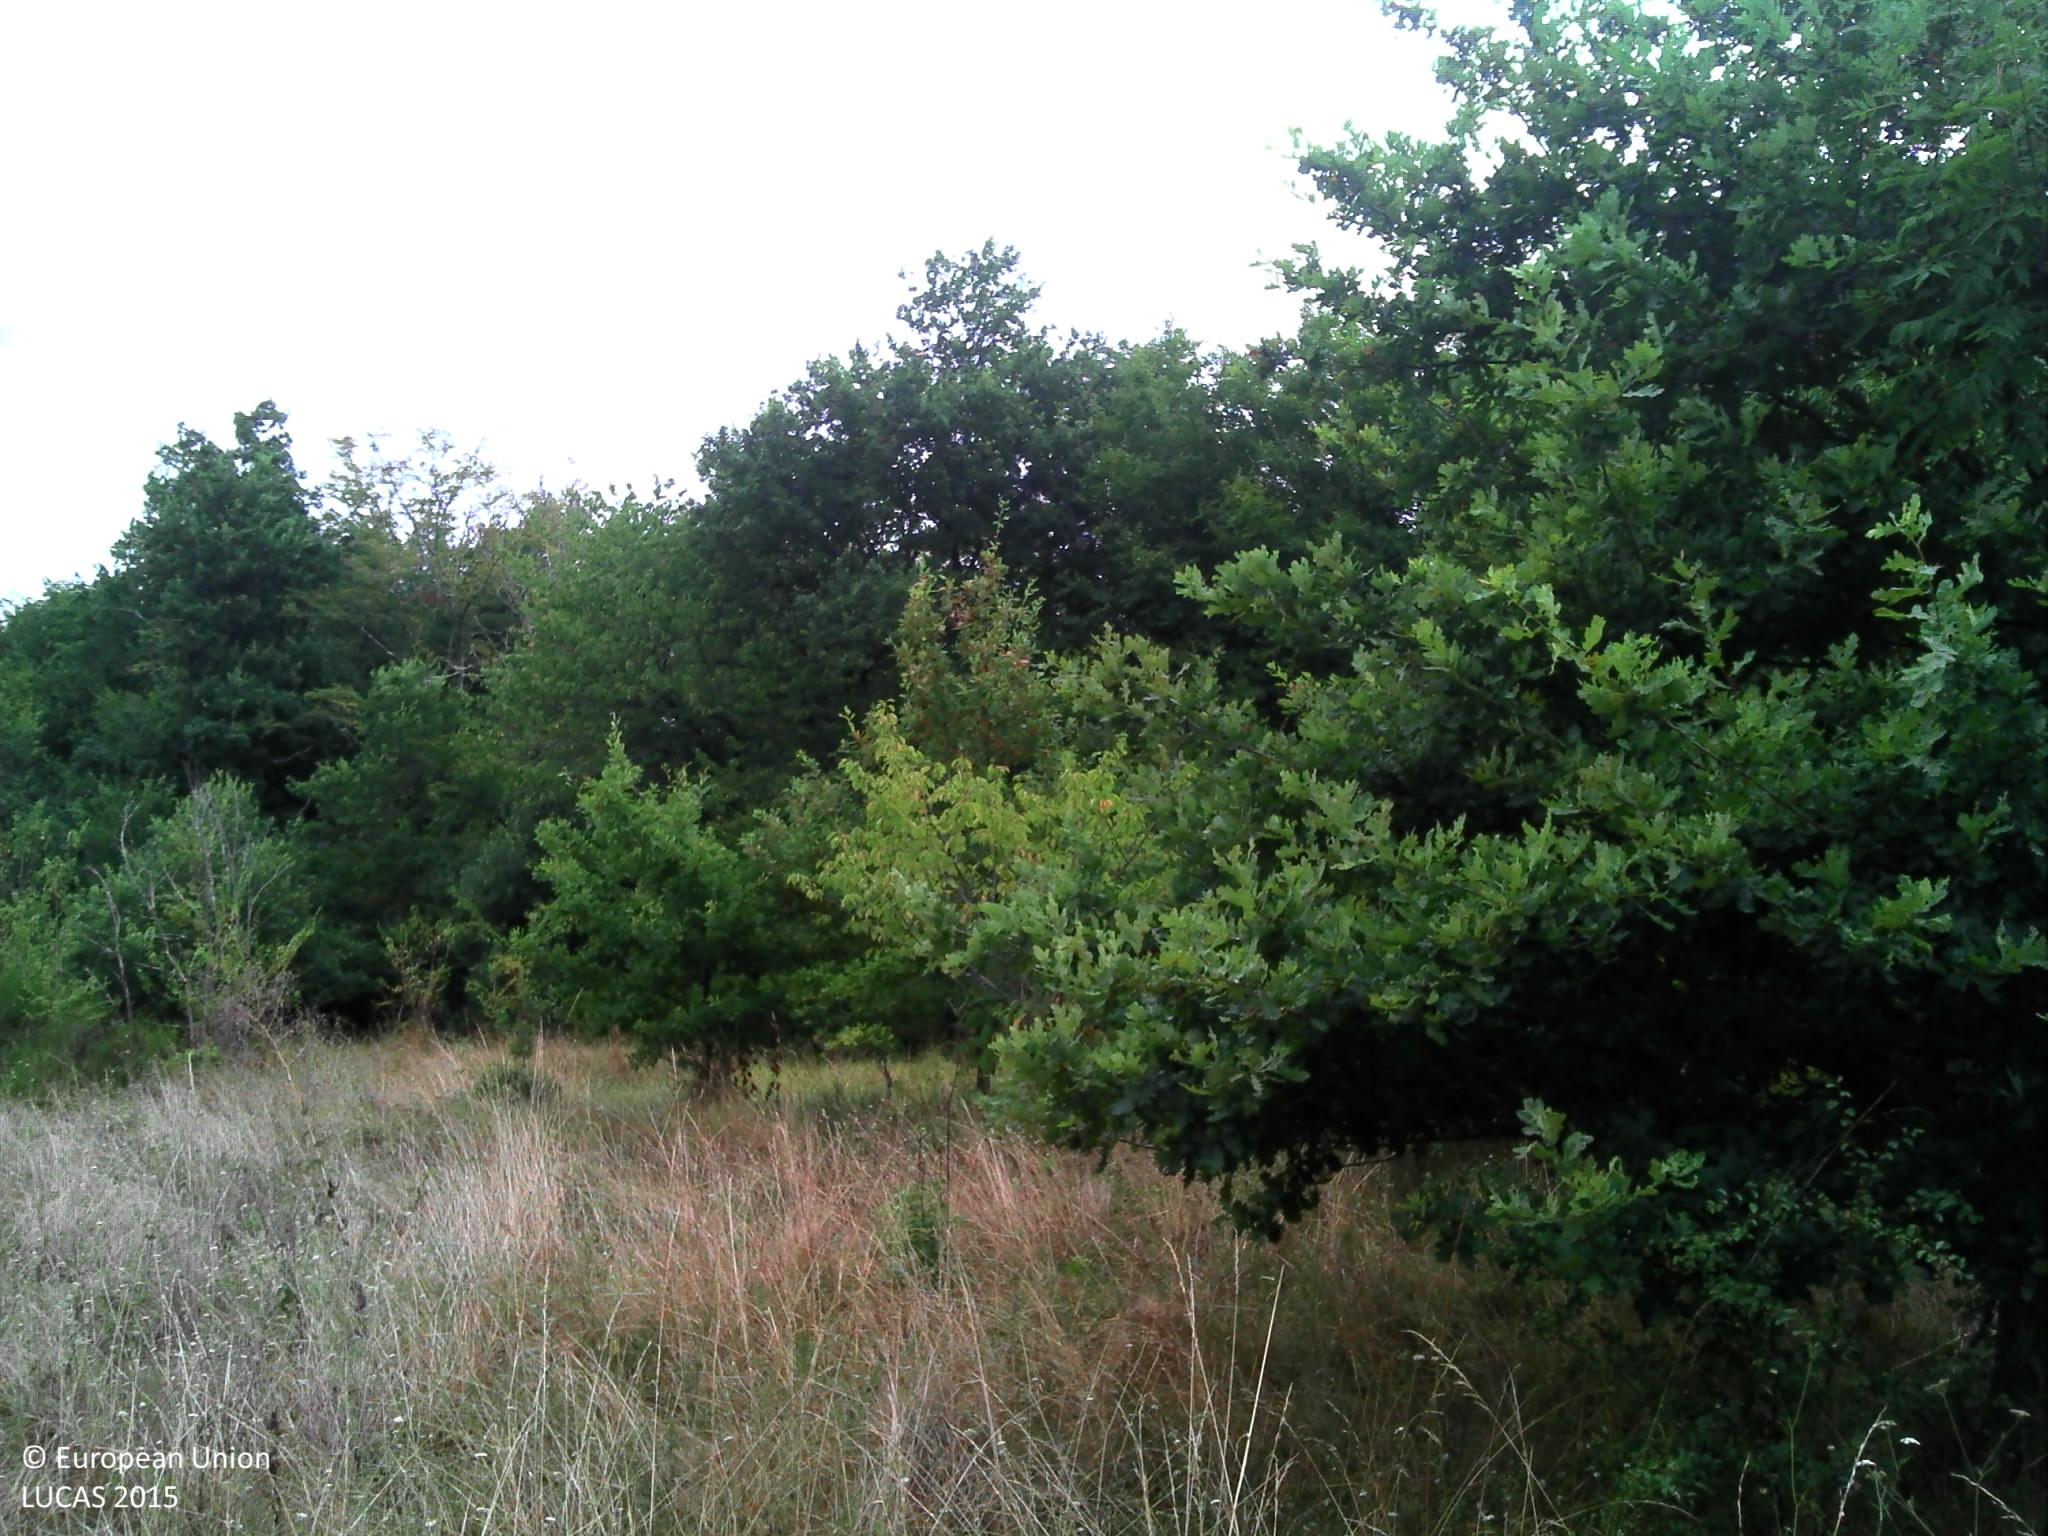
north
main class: Grassland
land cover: Grassland with sparse tree/shrub cover
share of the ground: > 75 %
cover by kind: herbaceous plants 80 %, shrubs 10 %, broadleaved forest trees 5 %, lichens and mosses 5 %
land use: Semi-natural and natural areas not in use
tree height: > 5 m
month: July
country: FR
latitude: 45.5756
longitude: 0.6199
